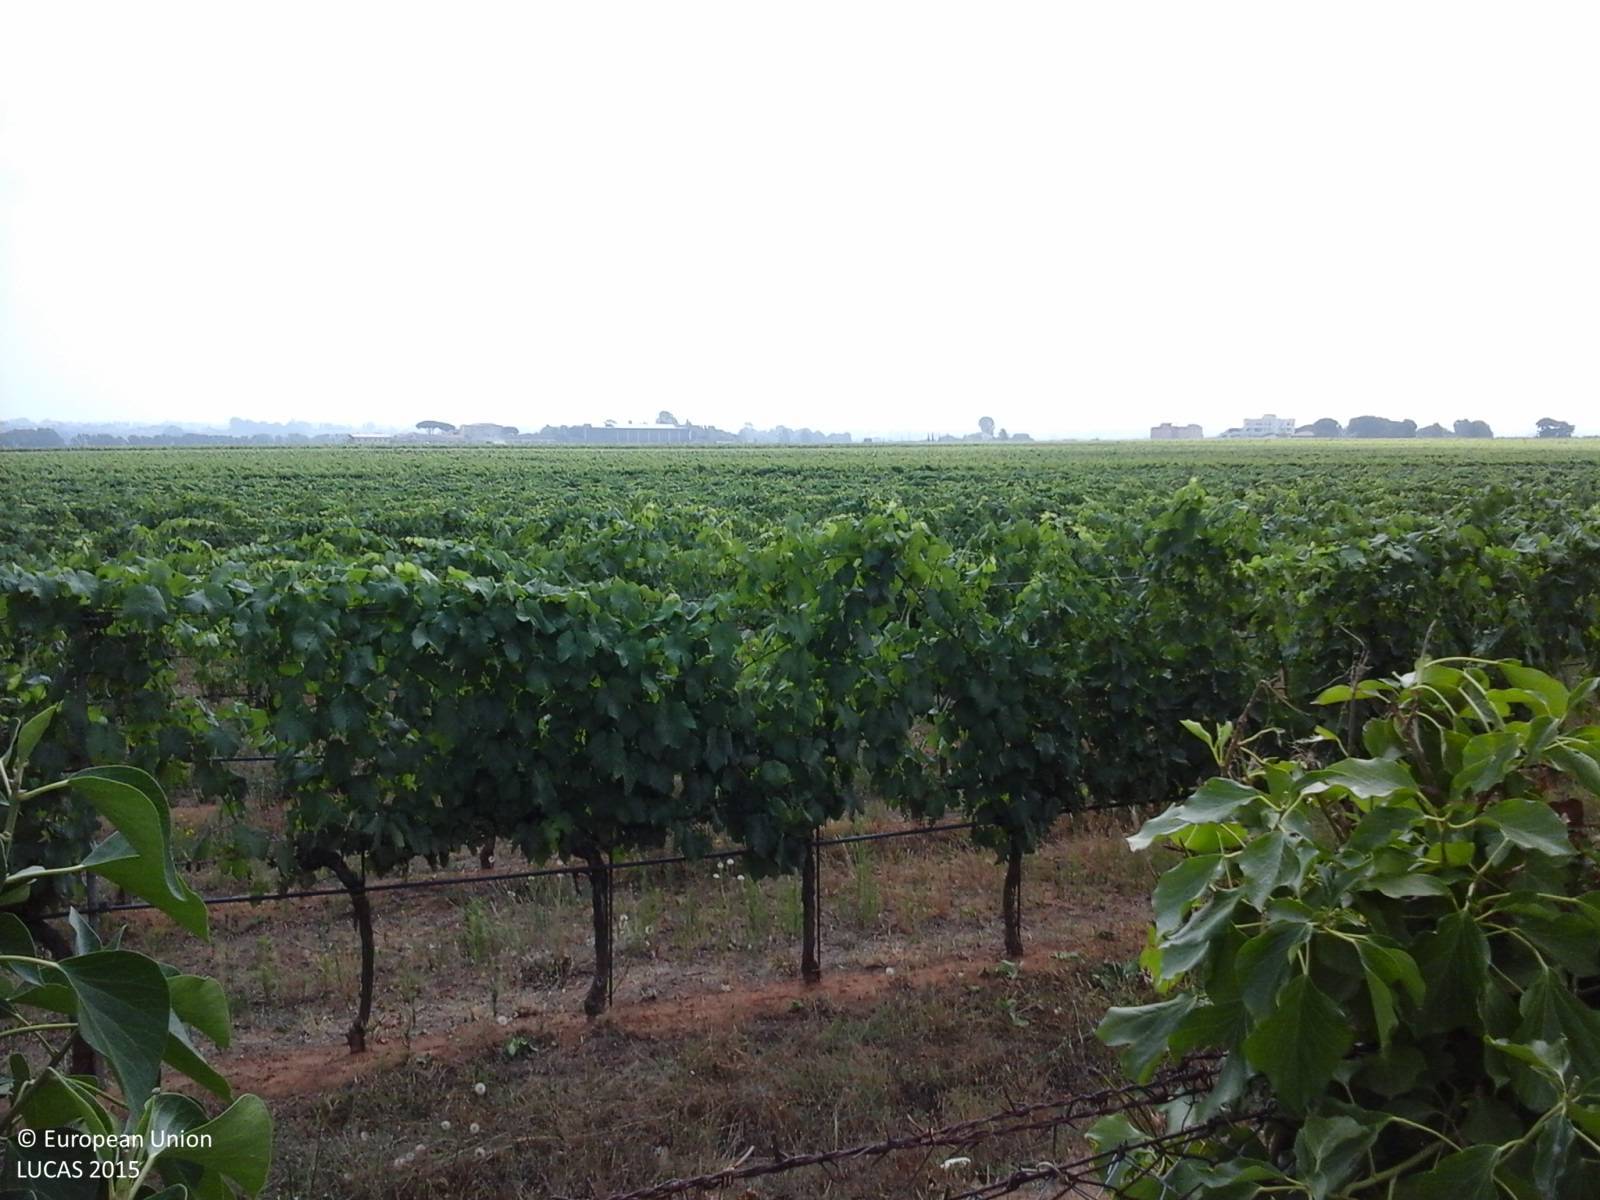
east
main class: Cropland
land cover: Vineyards
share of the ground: > 75 %
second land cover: Spontaneously vegetated surfaces
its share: > 75 %
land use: Agriculture (excluding fallow land and kitchen gardens)
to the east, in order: Vineyards; Spontaneously vegetated surfaces; Vineyards; Spontaneously vegetated surfaces; Tracks
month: July
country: IT
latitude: 41.5143
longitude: 12.7330
